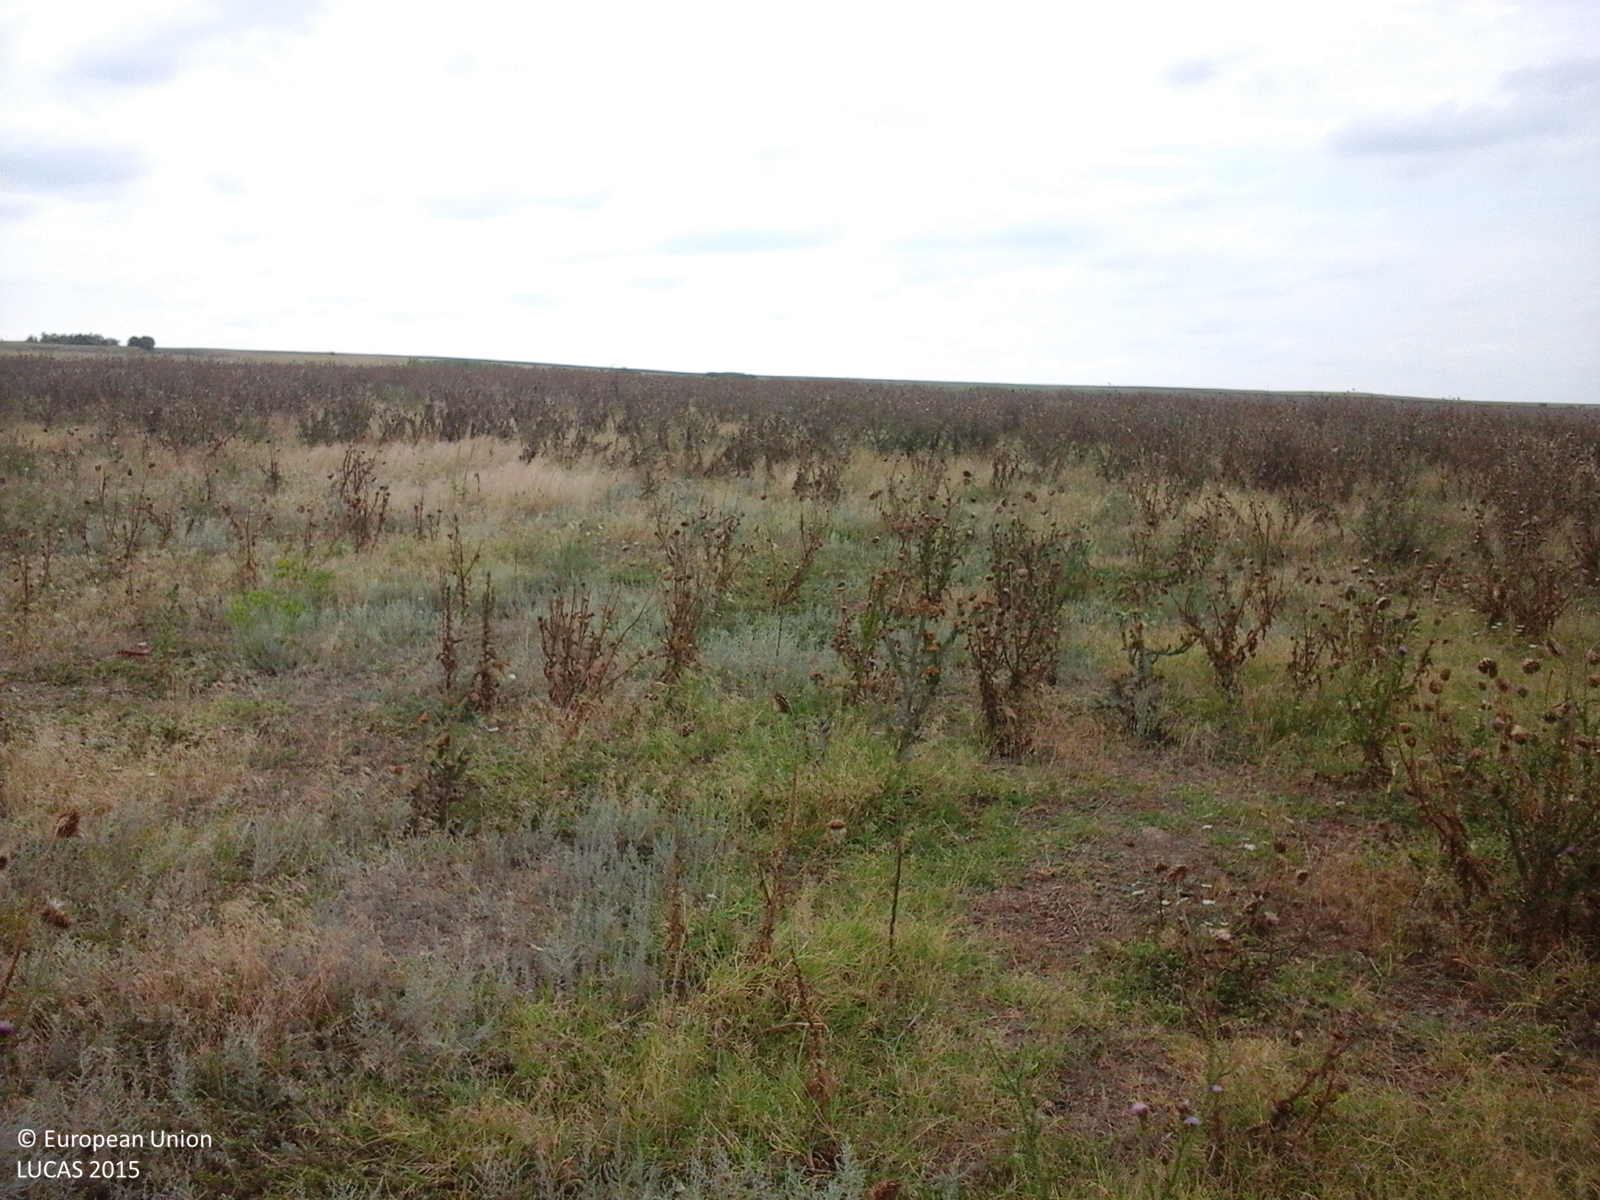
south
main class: Grassland
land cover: Spontaneously vegetated surfaces
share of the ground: > 75 %
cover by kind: herbaceous plants 100 %
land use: Fallow land
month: August
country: RO
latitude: 44.8250
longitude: 28.1118
